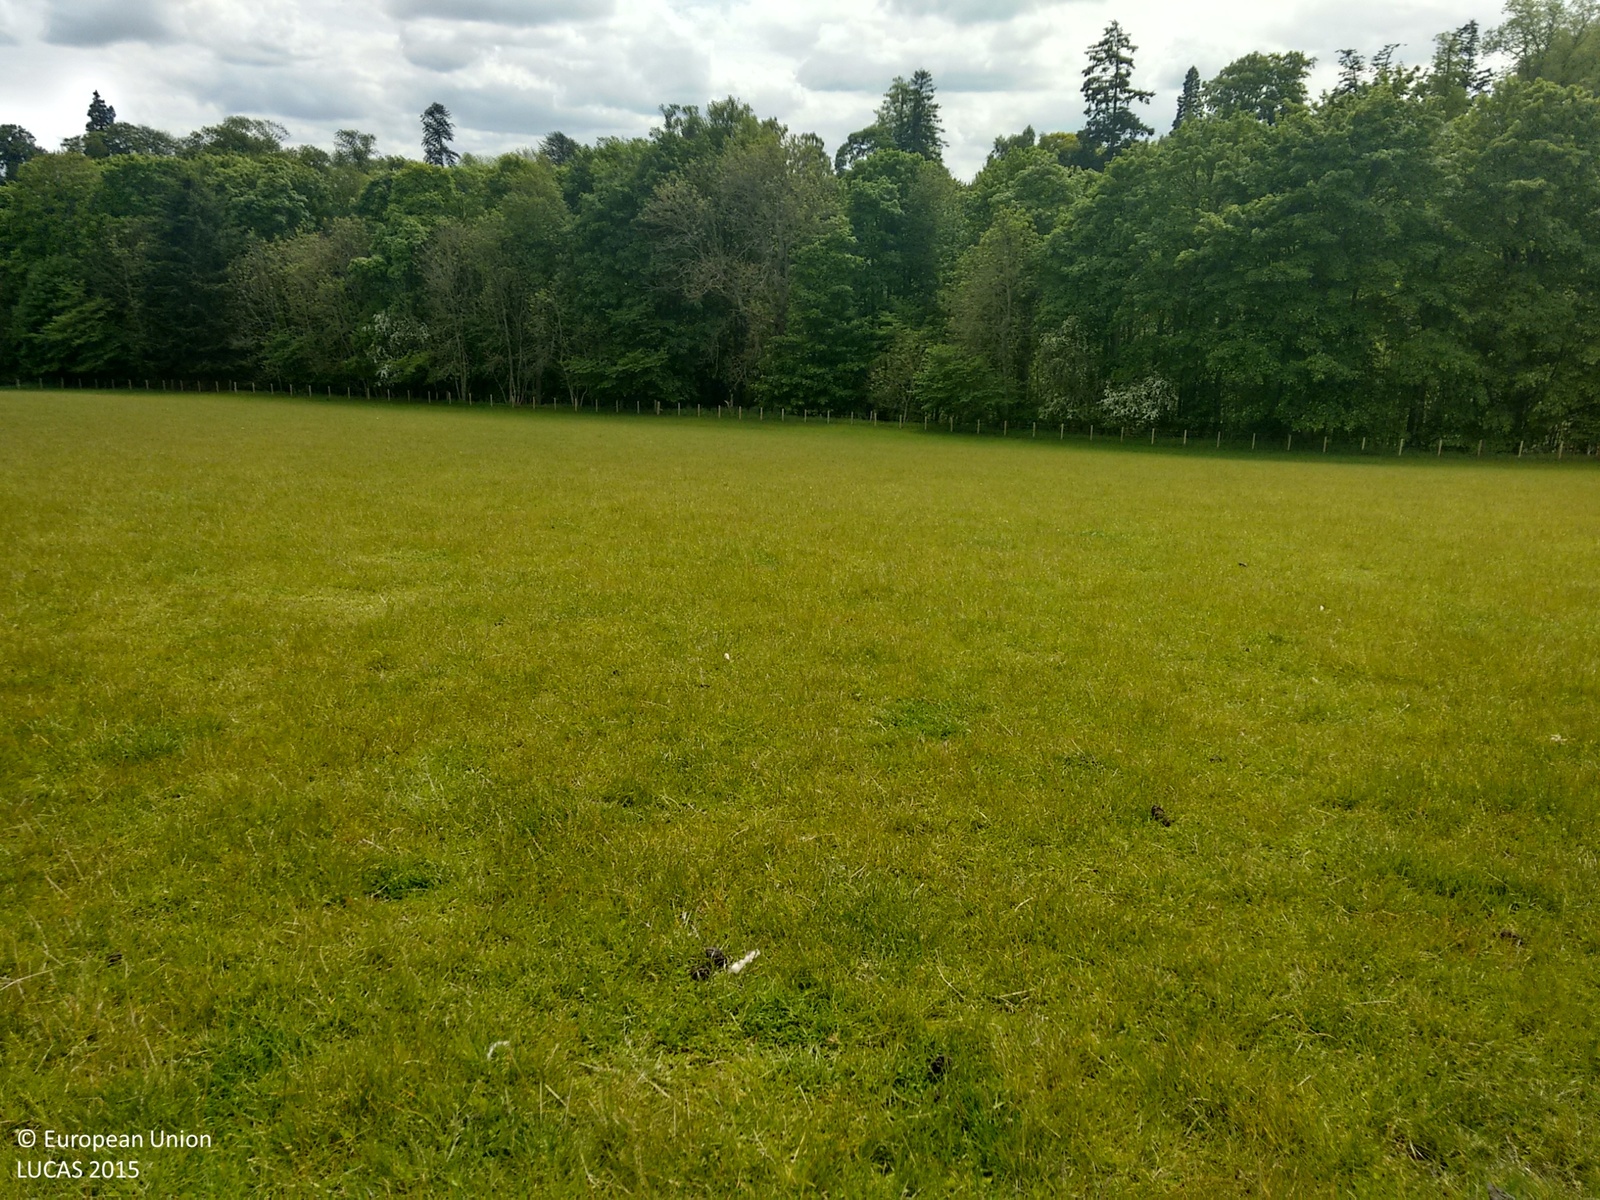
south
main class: Grassland
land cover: Grassland without tree/shrub cover
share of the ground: > 75 %
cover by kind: herbaceous plants 100 %
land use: Agriculture (excluding fallow land and kitchen gardens)
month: June
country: GB
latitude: 55.6316
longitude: -2.4652
